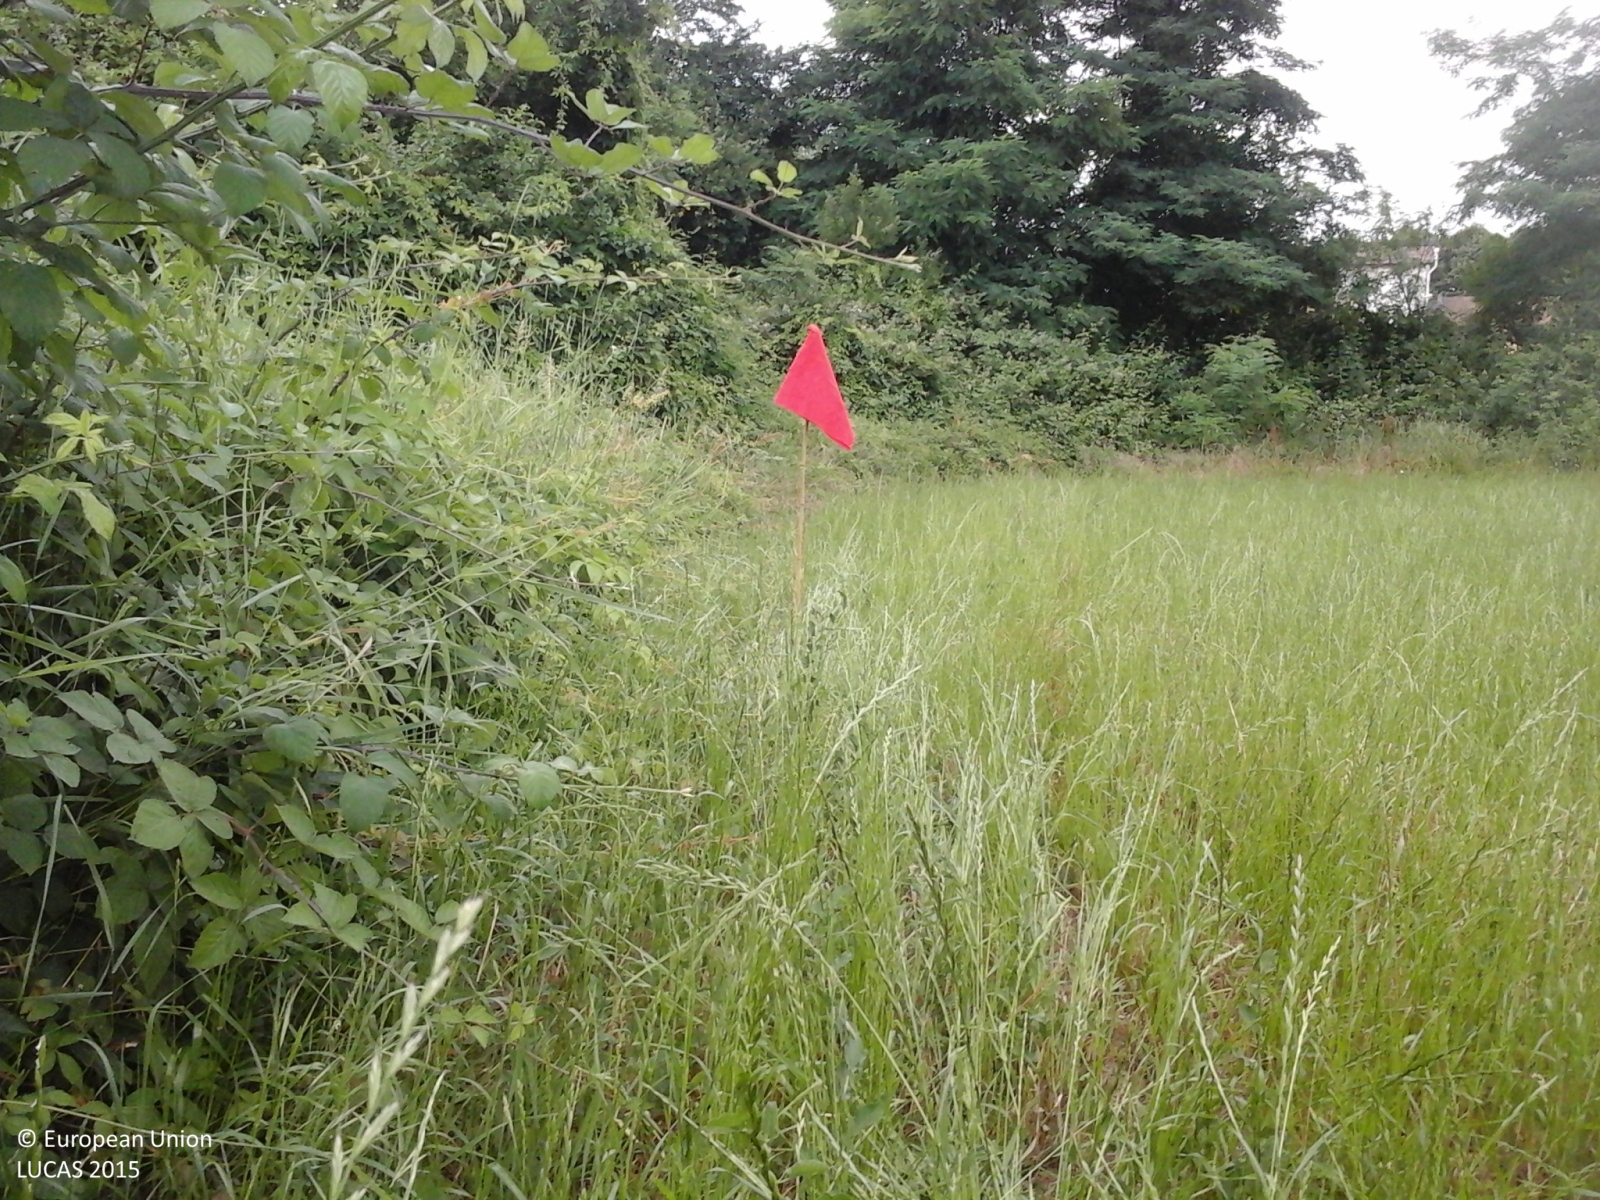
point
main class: Cropland
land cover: Temporary grasslands
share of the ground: > 75 %
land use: Agriculture (excluding fallow land and kitchen gardens)
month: June
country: IT
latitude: 45.4280
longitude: 10.9570
